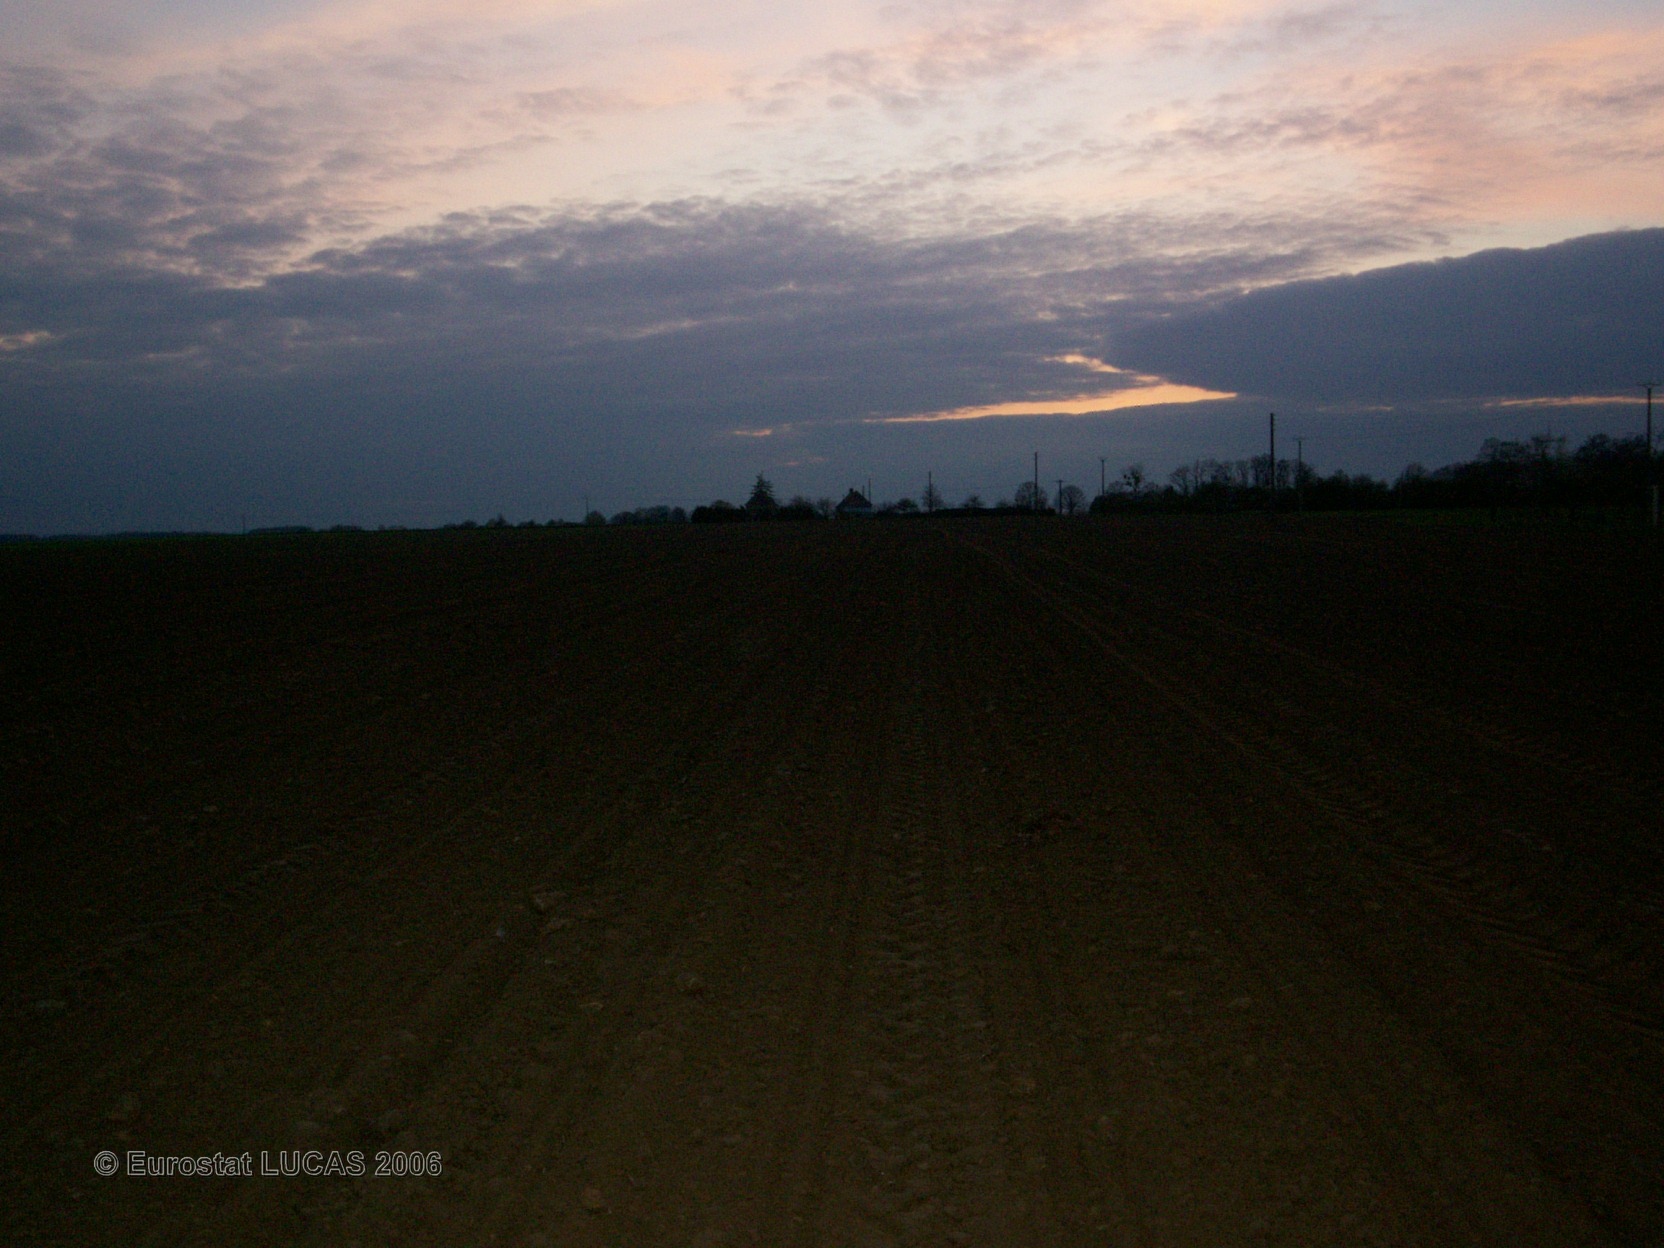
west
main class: Cropland
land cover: Maize
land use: Agriculture (excluding fallow land and kitchen gardens)
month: April
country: FR
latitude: 48.2863
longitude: 0.1204
